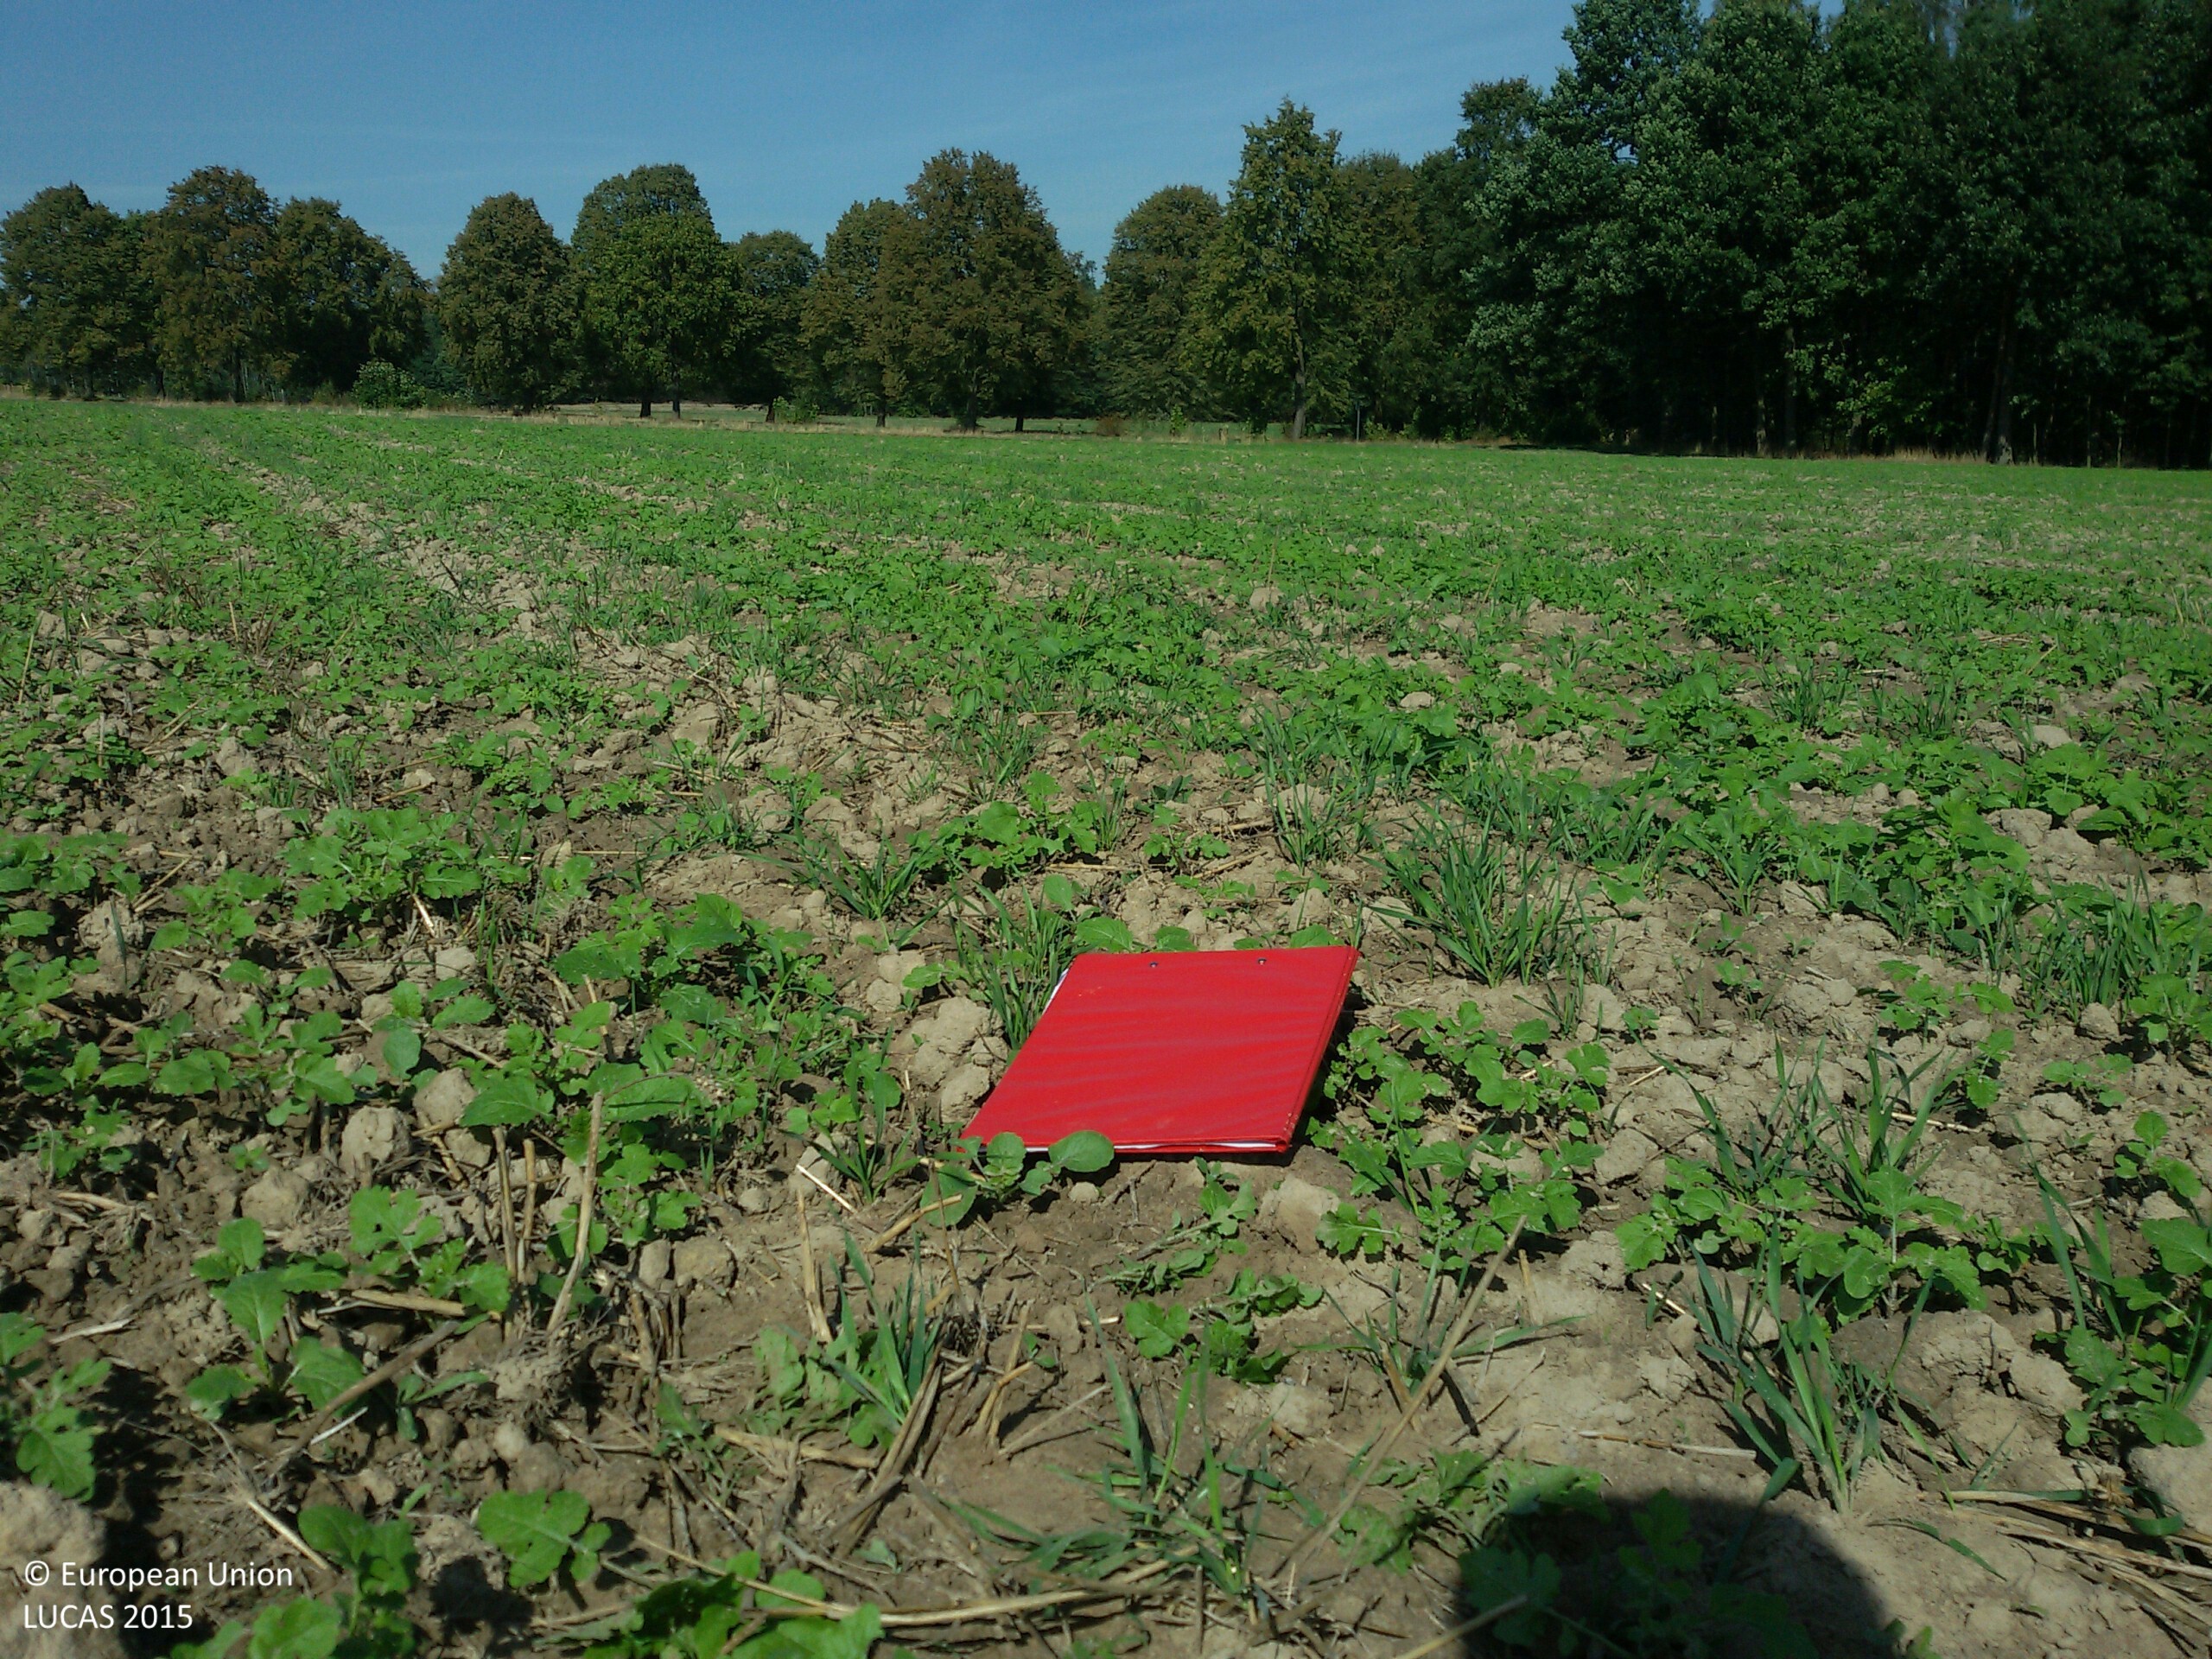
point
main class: Cropland
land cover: Rape and turnip rape
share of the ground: > 75 %
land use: Agriculture (excluding fallow land and kitchen gardens)
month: September
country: PL
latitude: 51.0235
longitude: 19.6527
